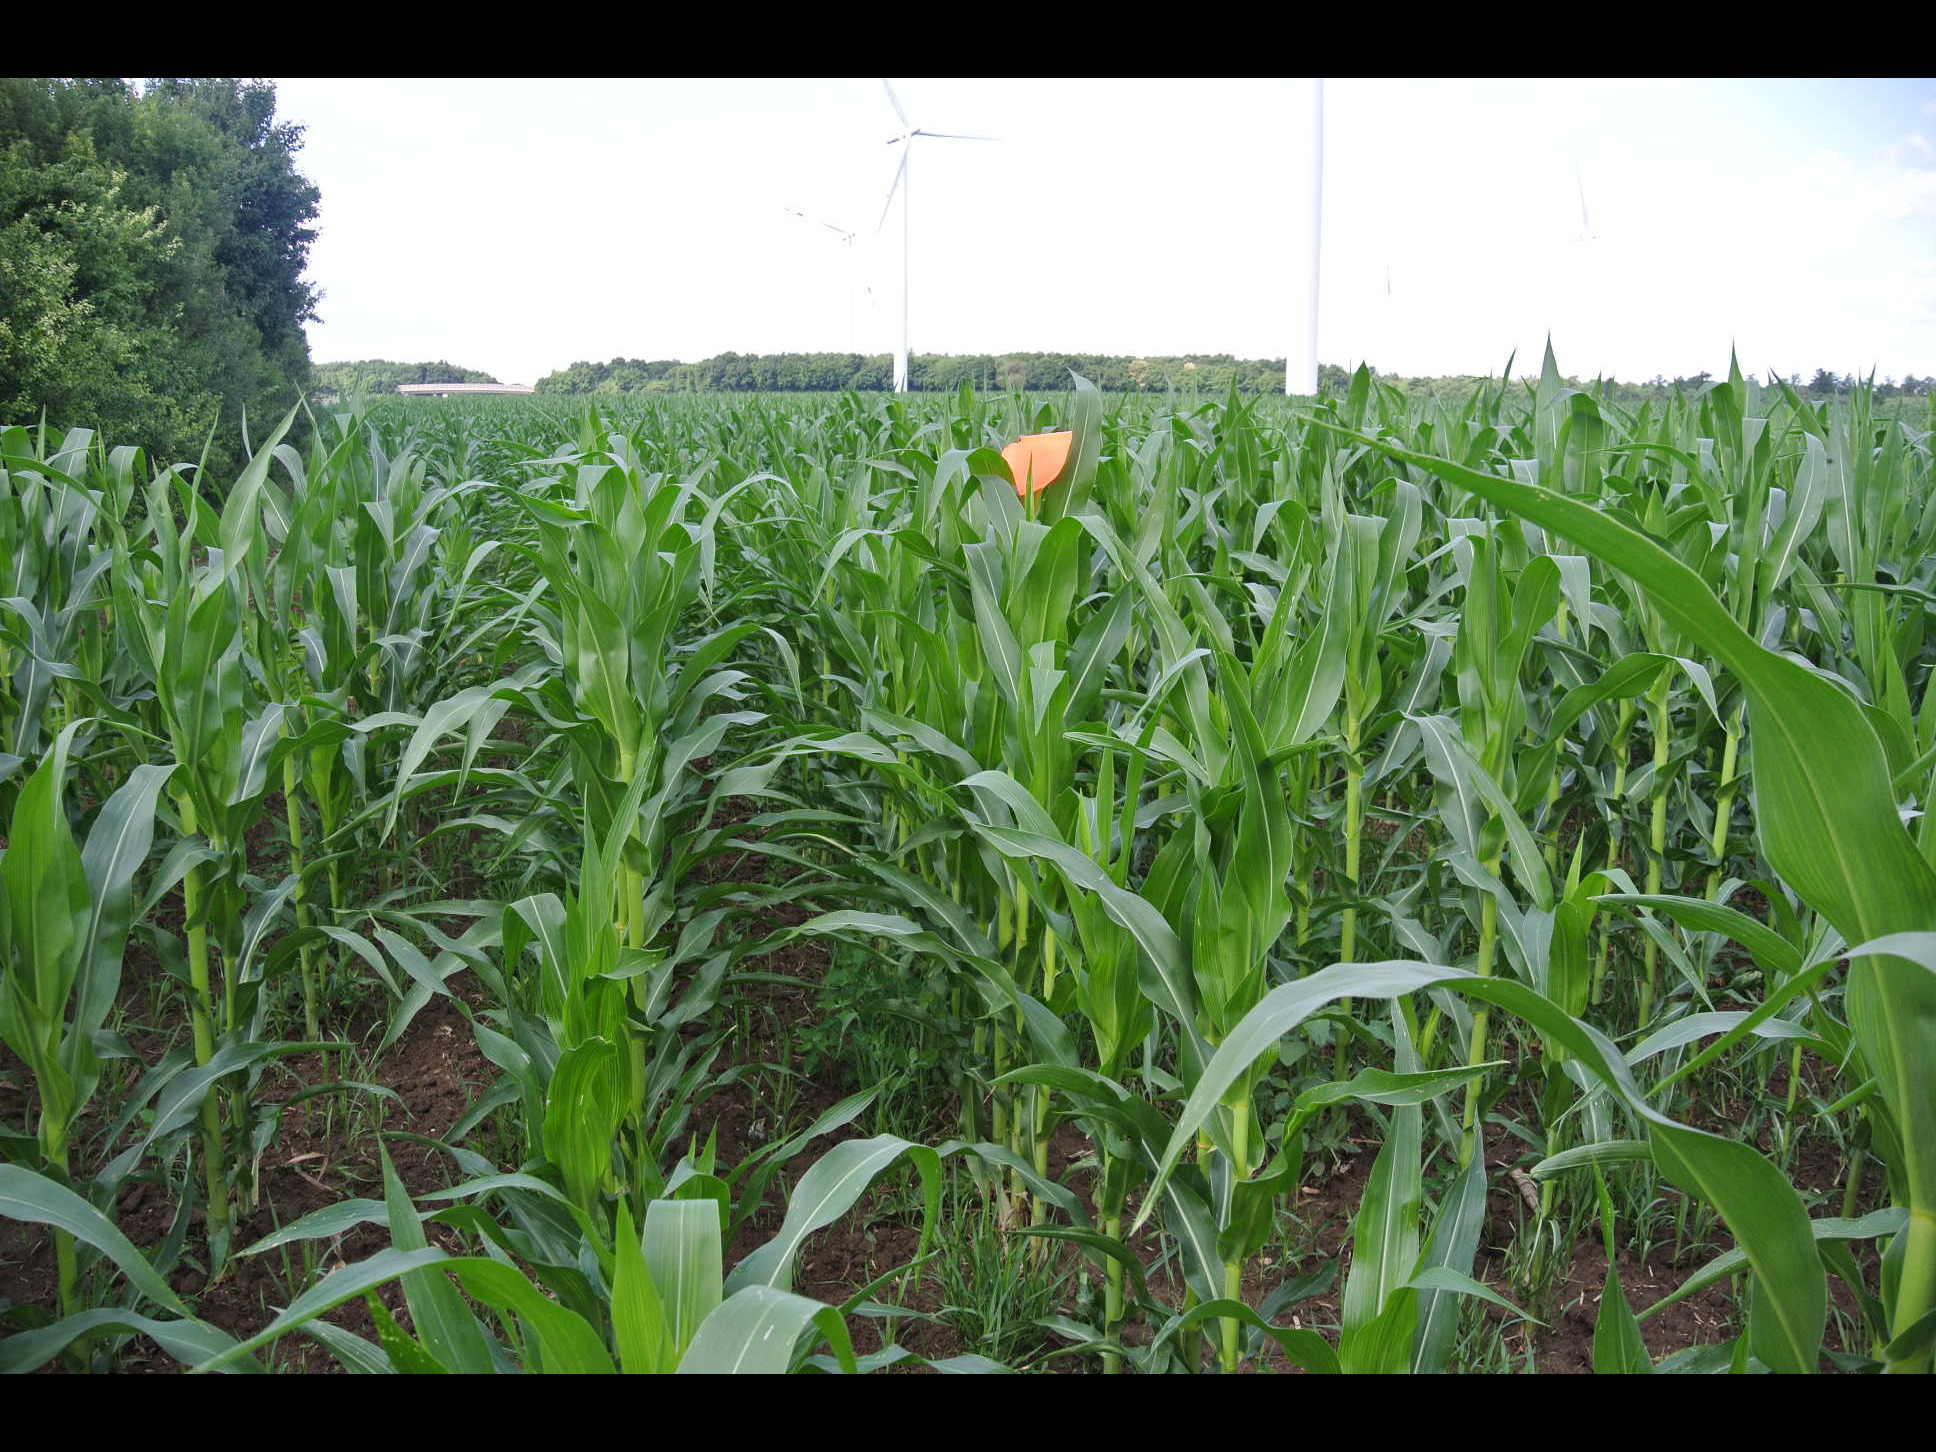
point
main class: Cropland
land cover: Maize
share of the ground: > 75 %
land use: Agriculture (excluding fallow land and kitchen gardens)
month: July
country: AT
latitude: 47.7655
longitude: 16.4219
